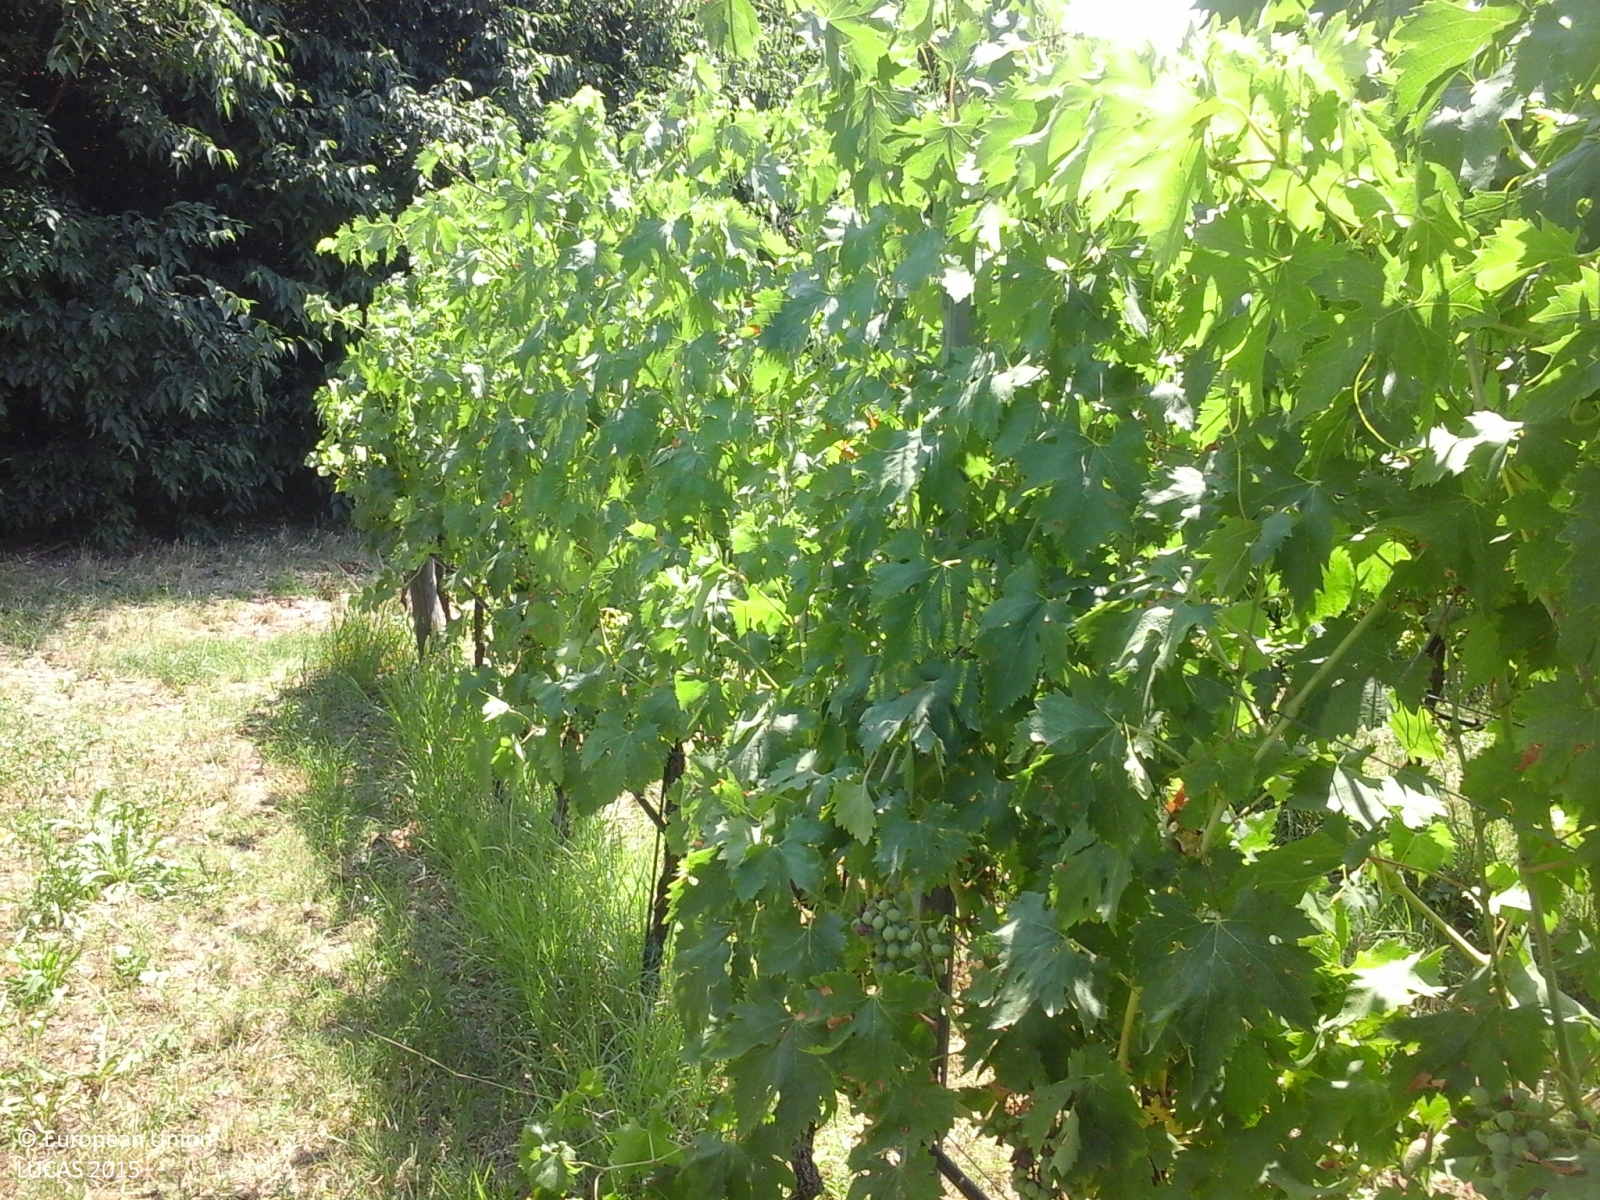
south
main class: Cropland
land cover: Vineyards
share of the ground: 25 - 50 %
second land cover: Grassland without tree/shrub cover
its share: > 75 %
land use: Agriculture (excluding fallow land and kitchen gardens)
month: July
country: IT
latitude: 45.4625
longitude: 11.1108
